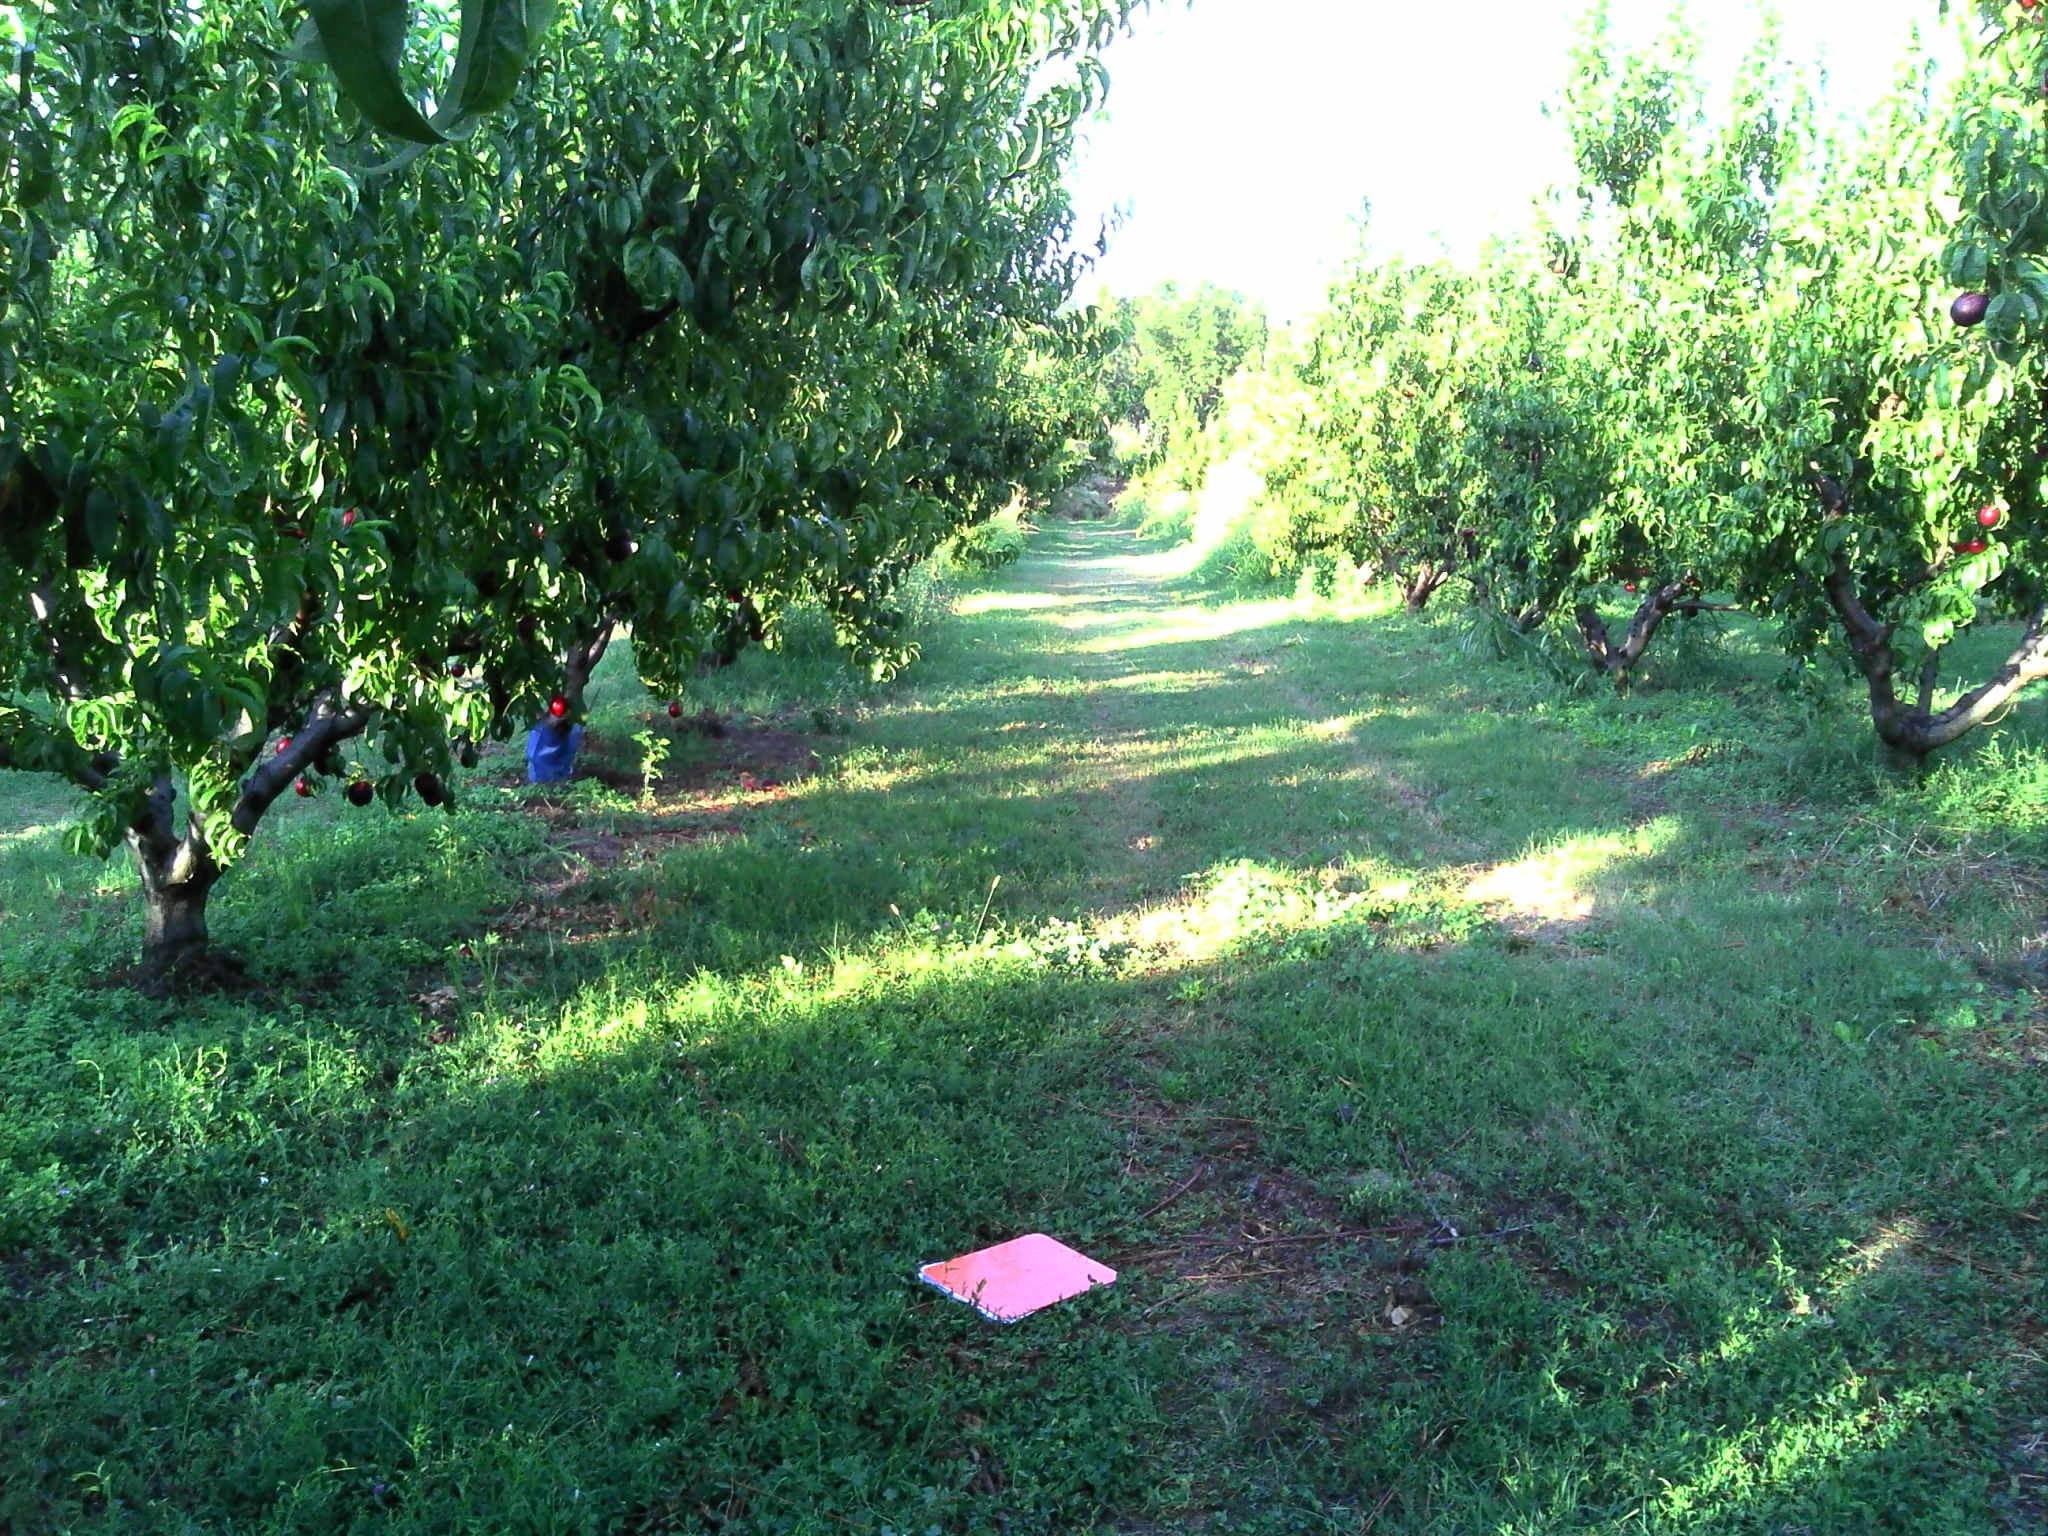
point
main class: Cropland
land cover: Other fruit trees and berries
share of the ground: 50 - 75 %
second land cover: Grassland without tree/shrub cover
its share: 25 - 50 %
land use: Agriculture (excluding fallow land and kitchen gardens)
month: August
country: FR
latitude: 44.2839
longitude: 4.6317
